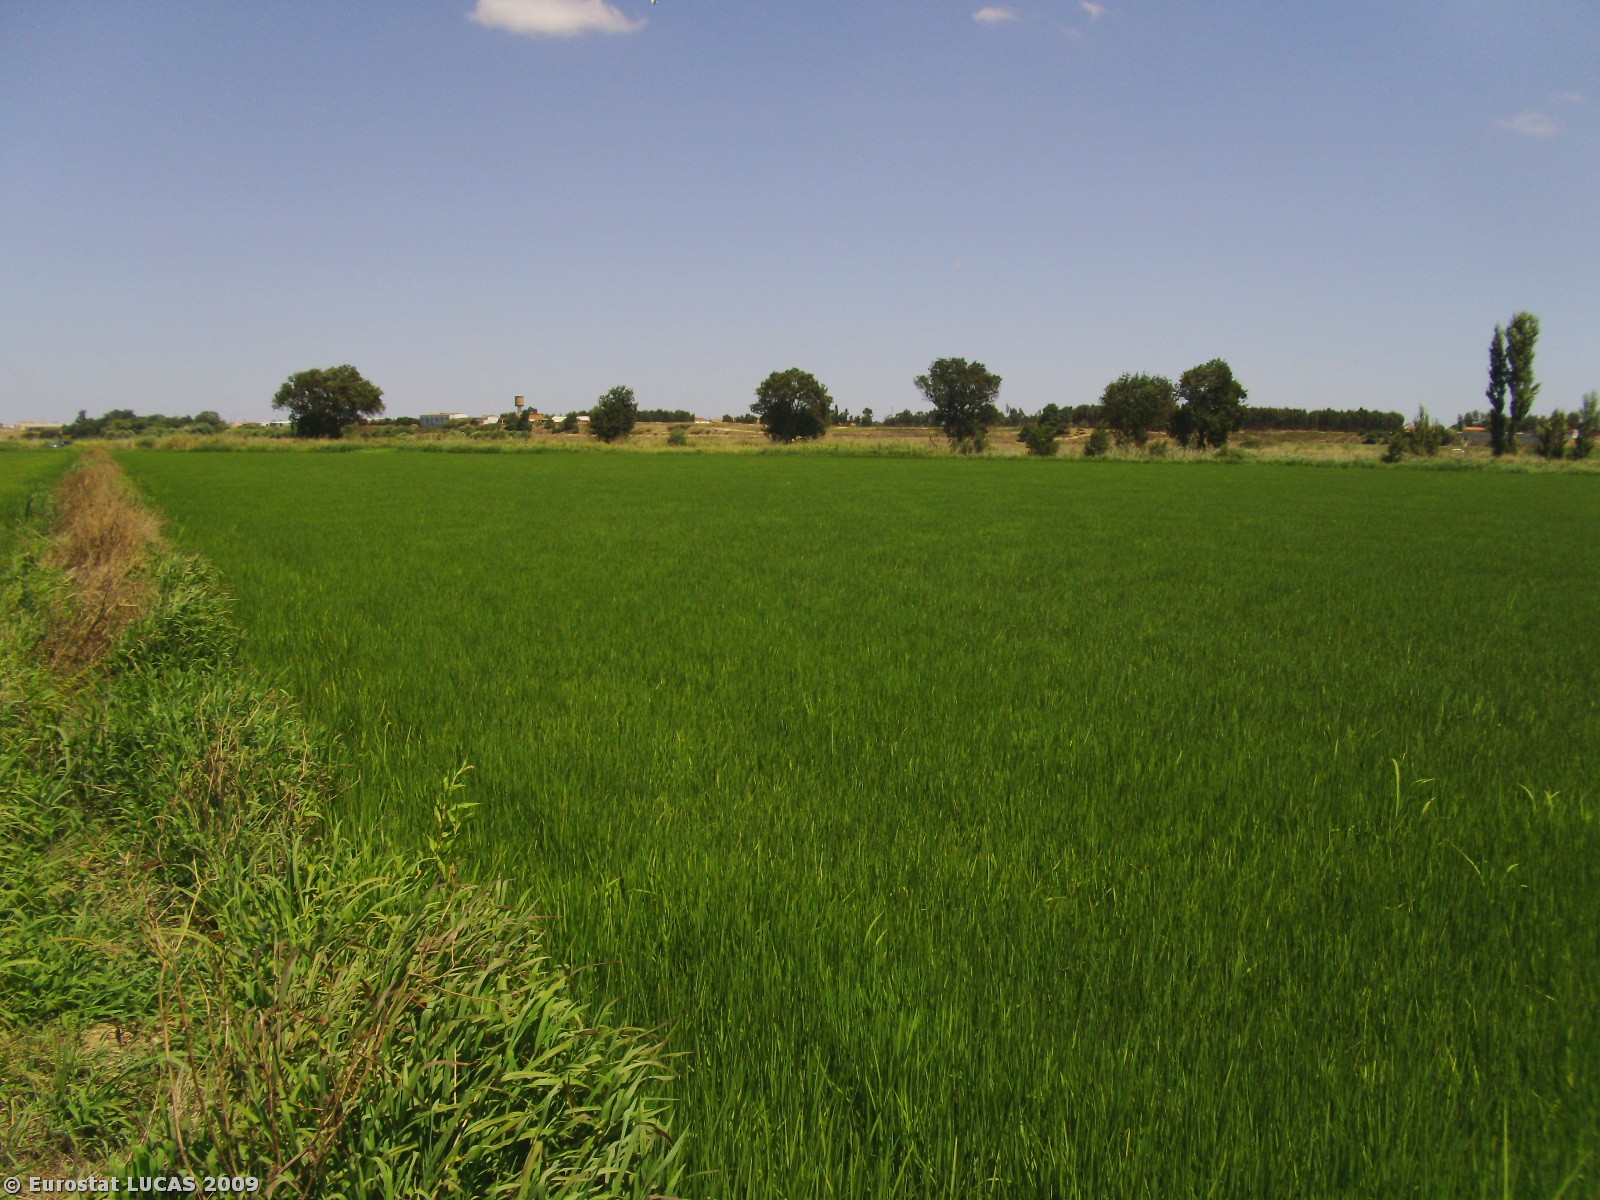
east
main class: Cropland
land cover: Rice
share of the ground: > 75 %
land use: Agriculture (excluding fallow land and kitchen gardens)
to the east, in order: Rice; Shruby margins; Ditches and canals; Shruby margins; Tracks; Shruby margins; Ditches and canals; Shrubland without tree cover; Other fresh vegetables
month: July
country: PT
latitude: 39.0204
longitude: -8.8177
